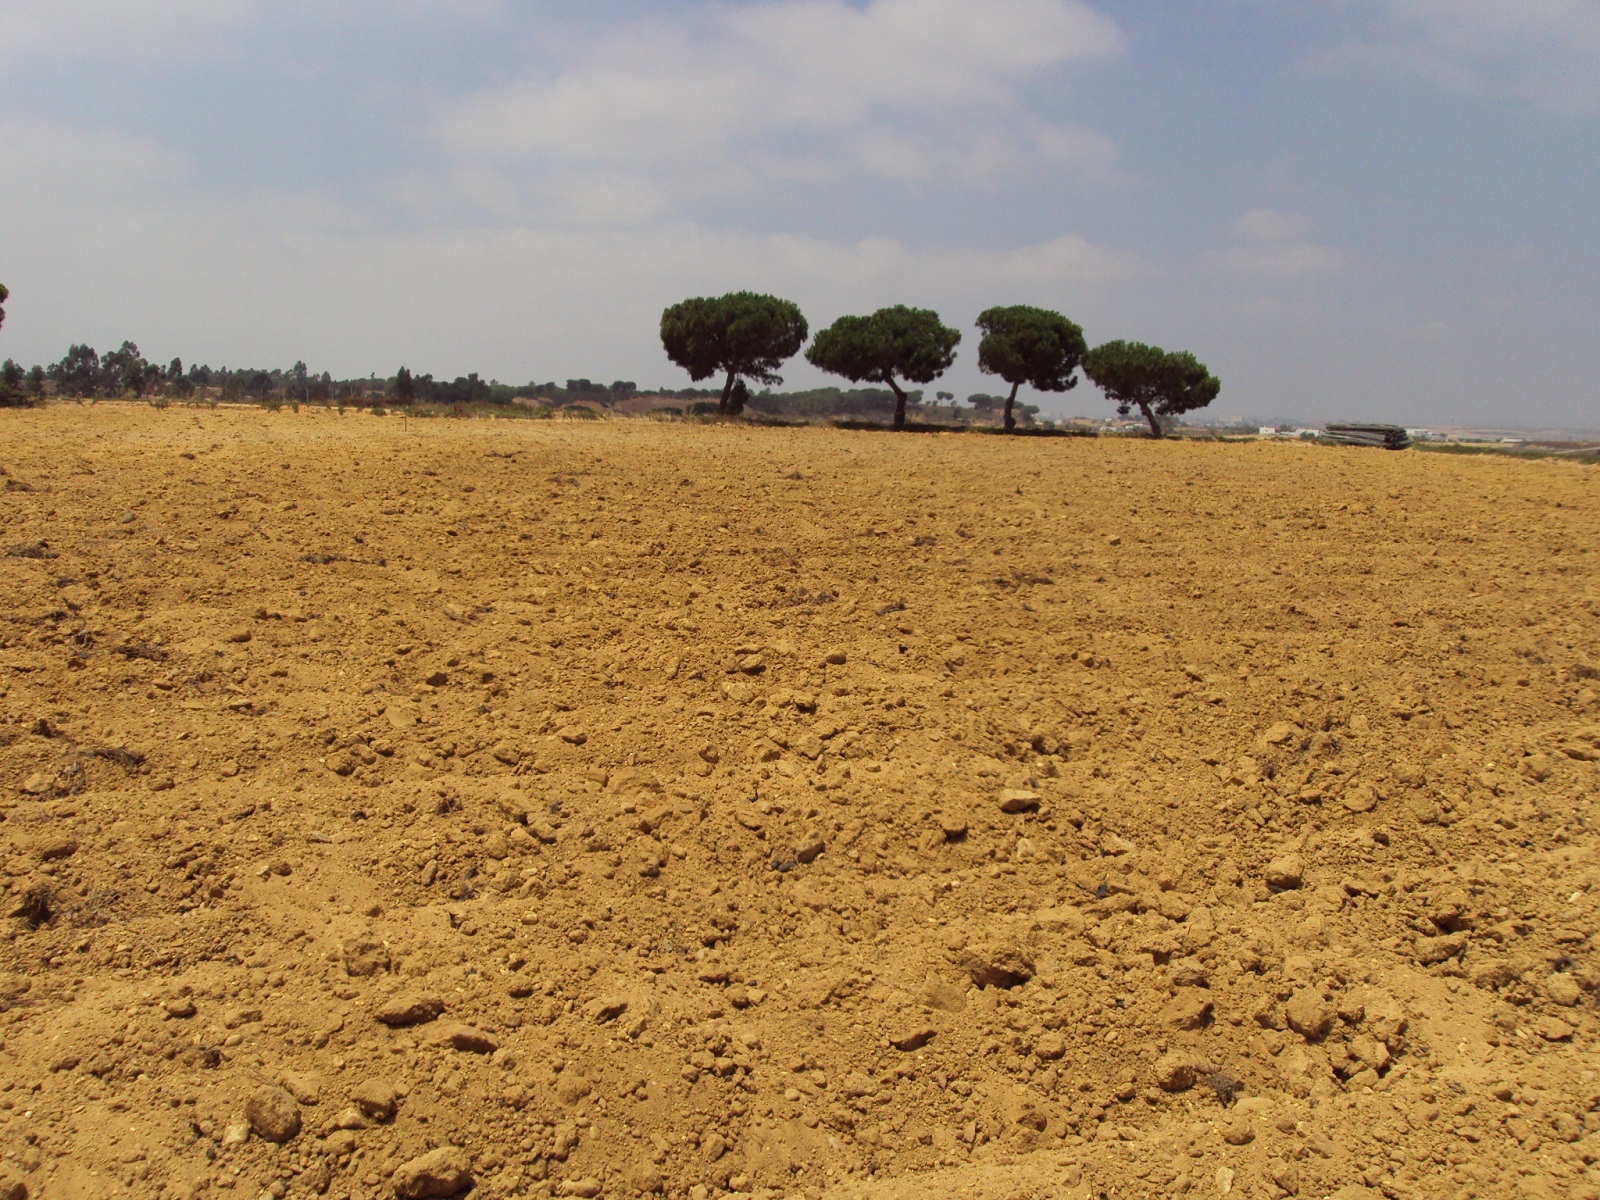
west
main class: Cropland
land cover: Strawberries
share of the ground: > 75 %
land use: Agriculture (excluding fallow land and kitchen gardens)
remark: Harvested field
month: June
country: ES
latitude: 37.2490
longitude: -6.8454
